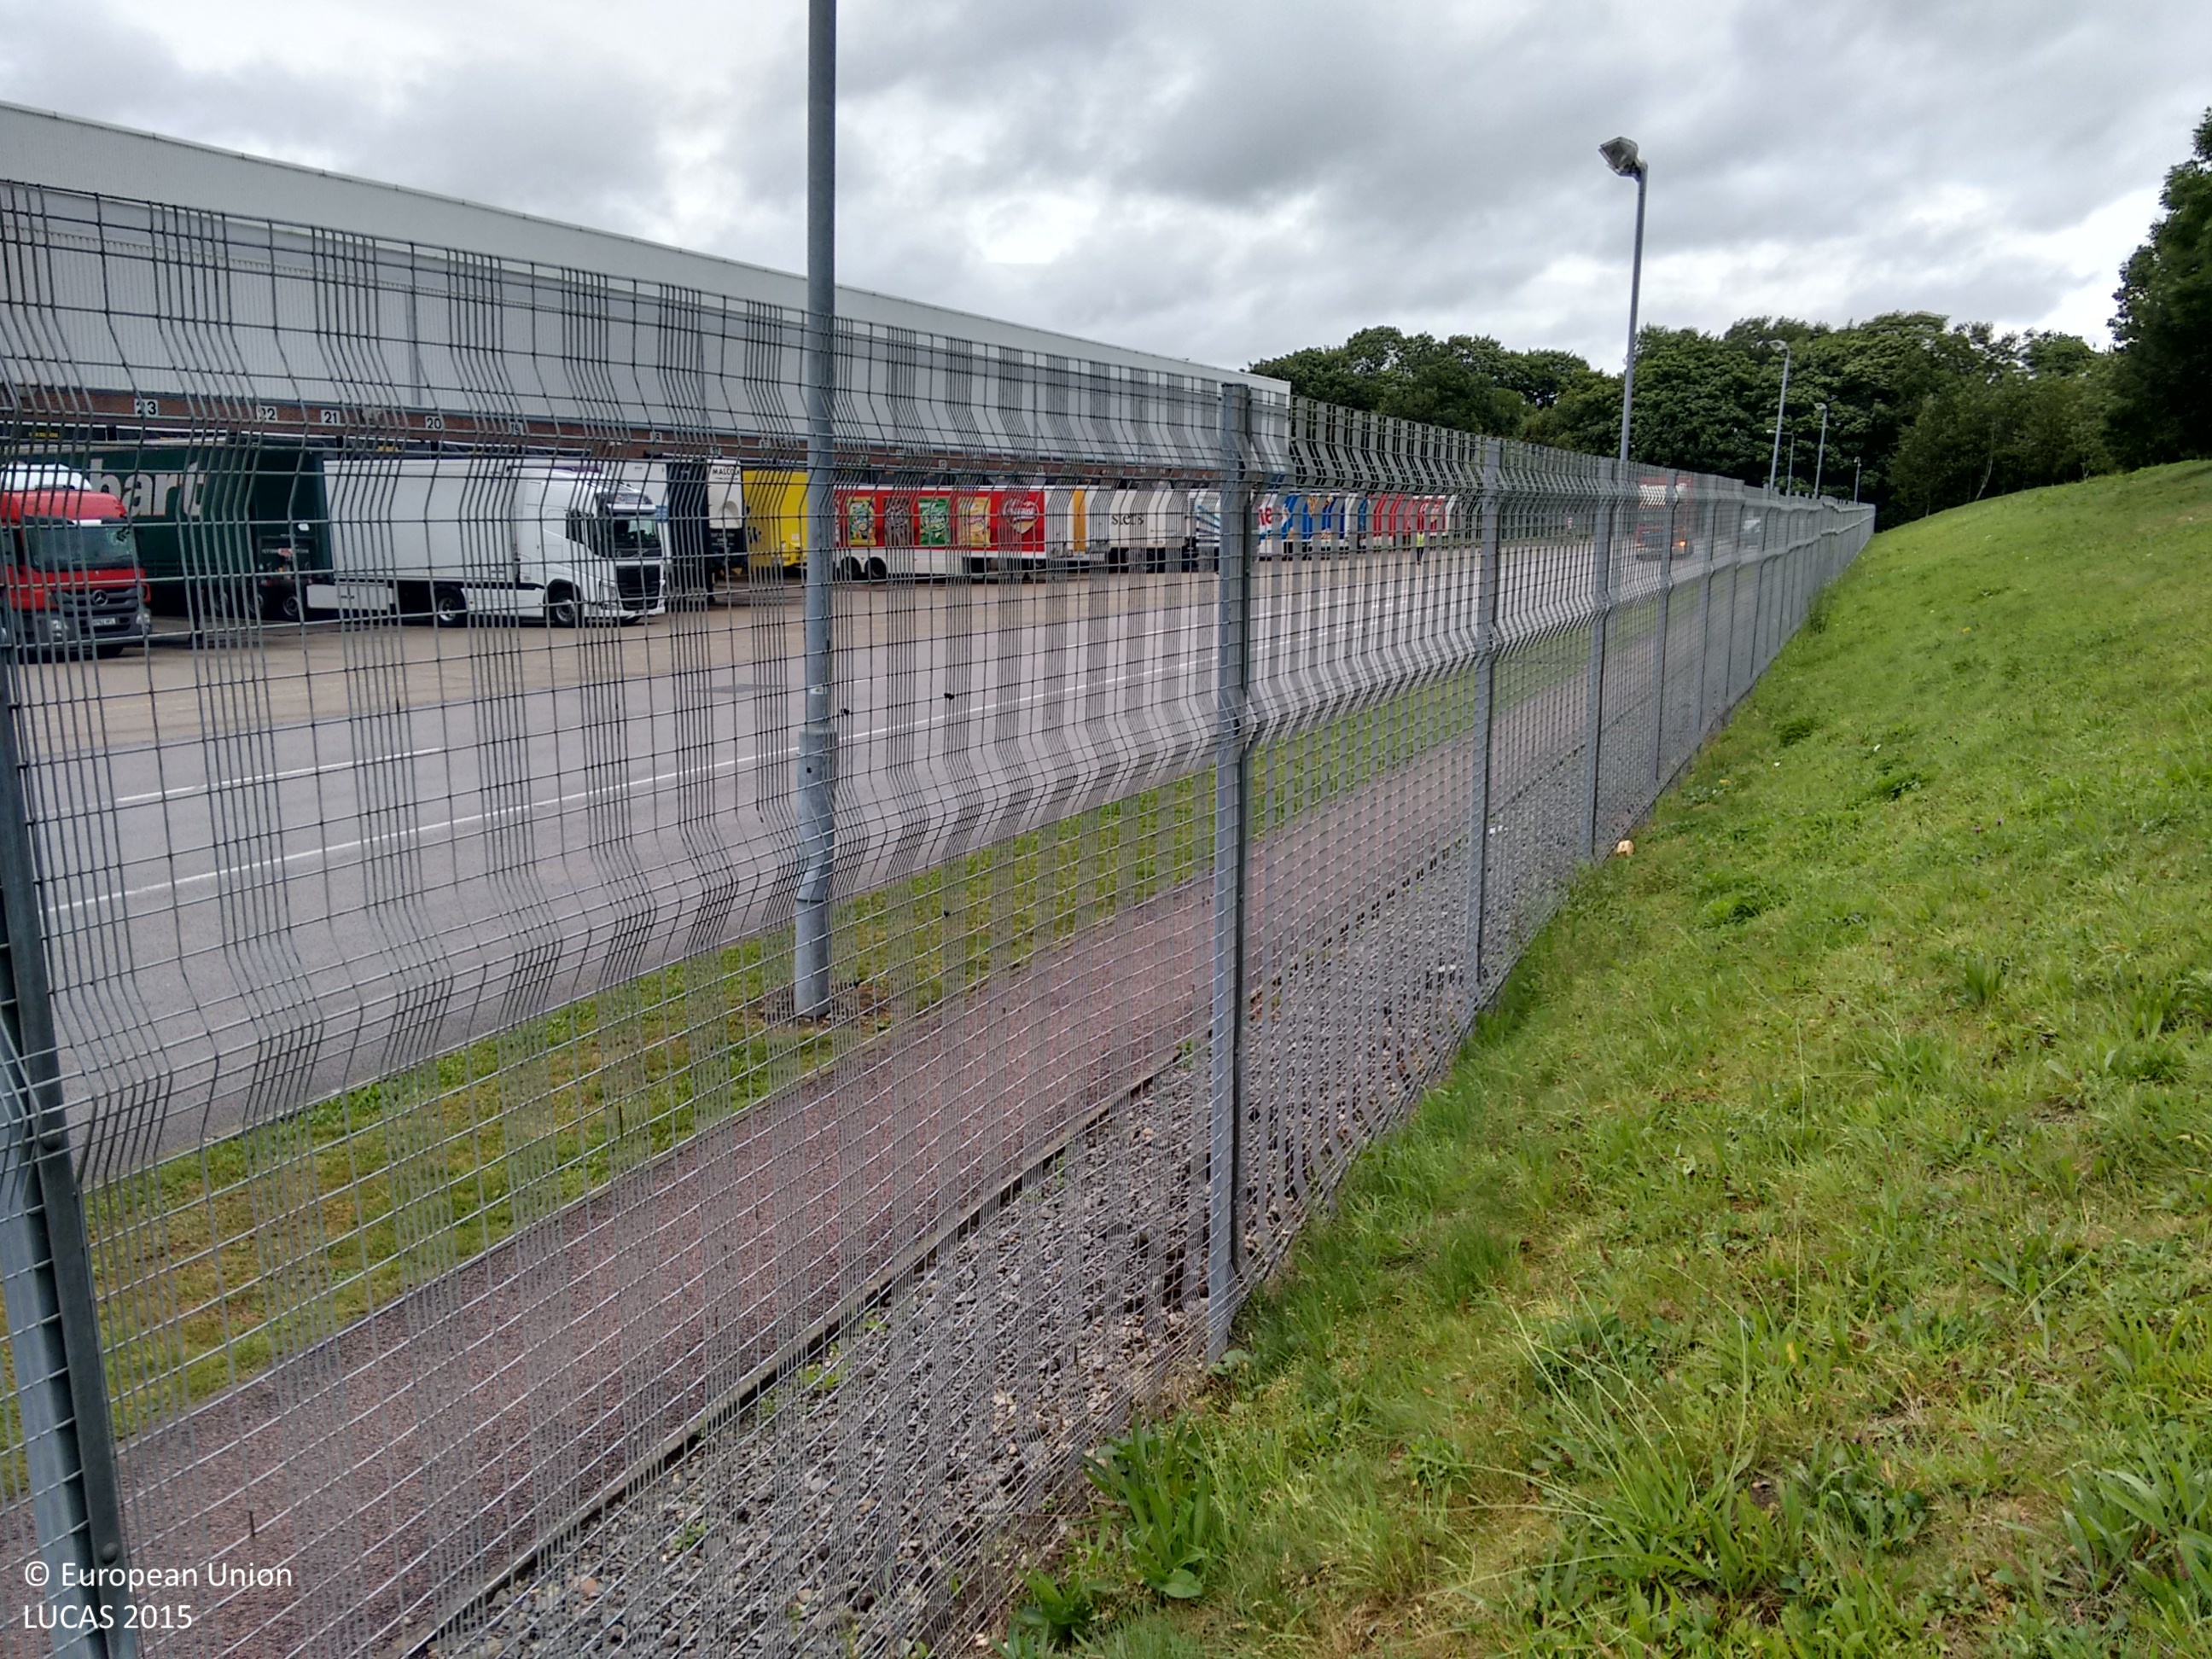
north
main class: Grassland
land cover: Grassland without tree/shrub cover
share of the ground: > 75 %
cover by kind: herbaceous plants 100 %
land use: Logistics and storage
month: August
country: GB
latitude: 52.7038
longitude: -1.3405
